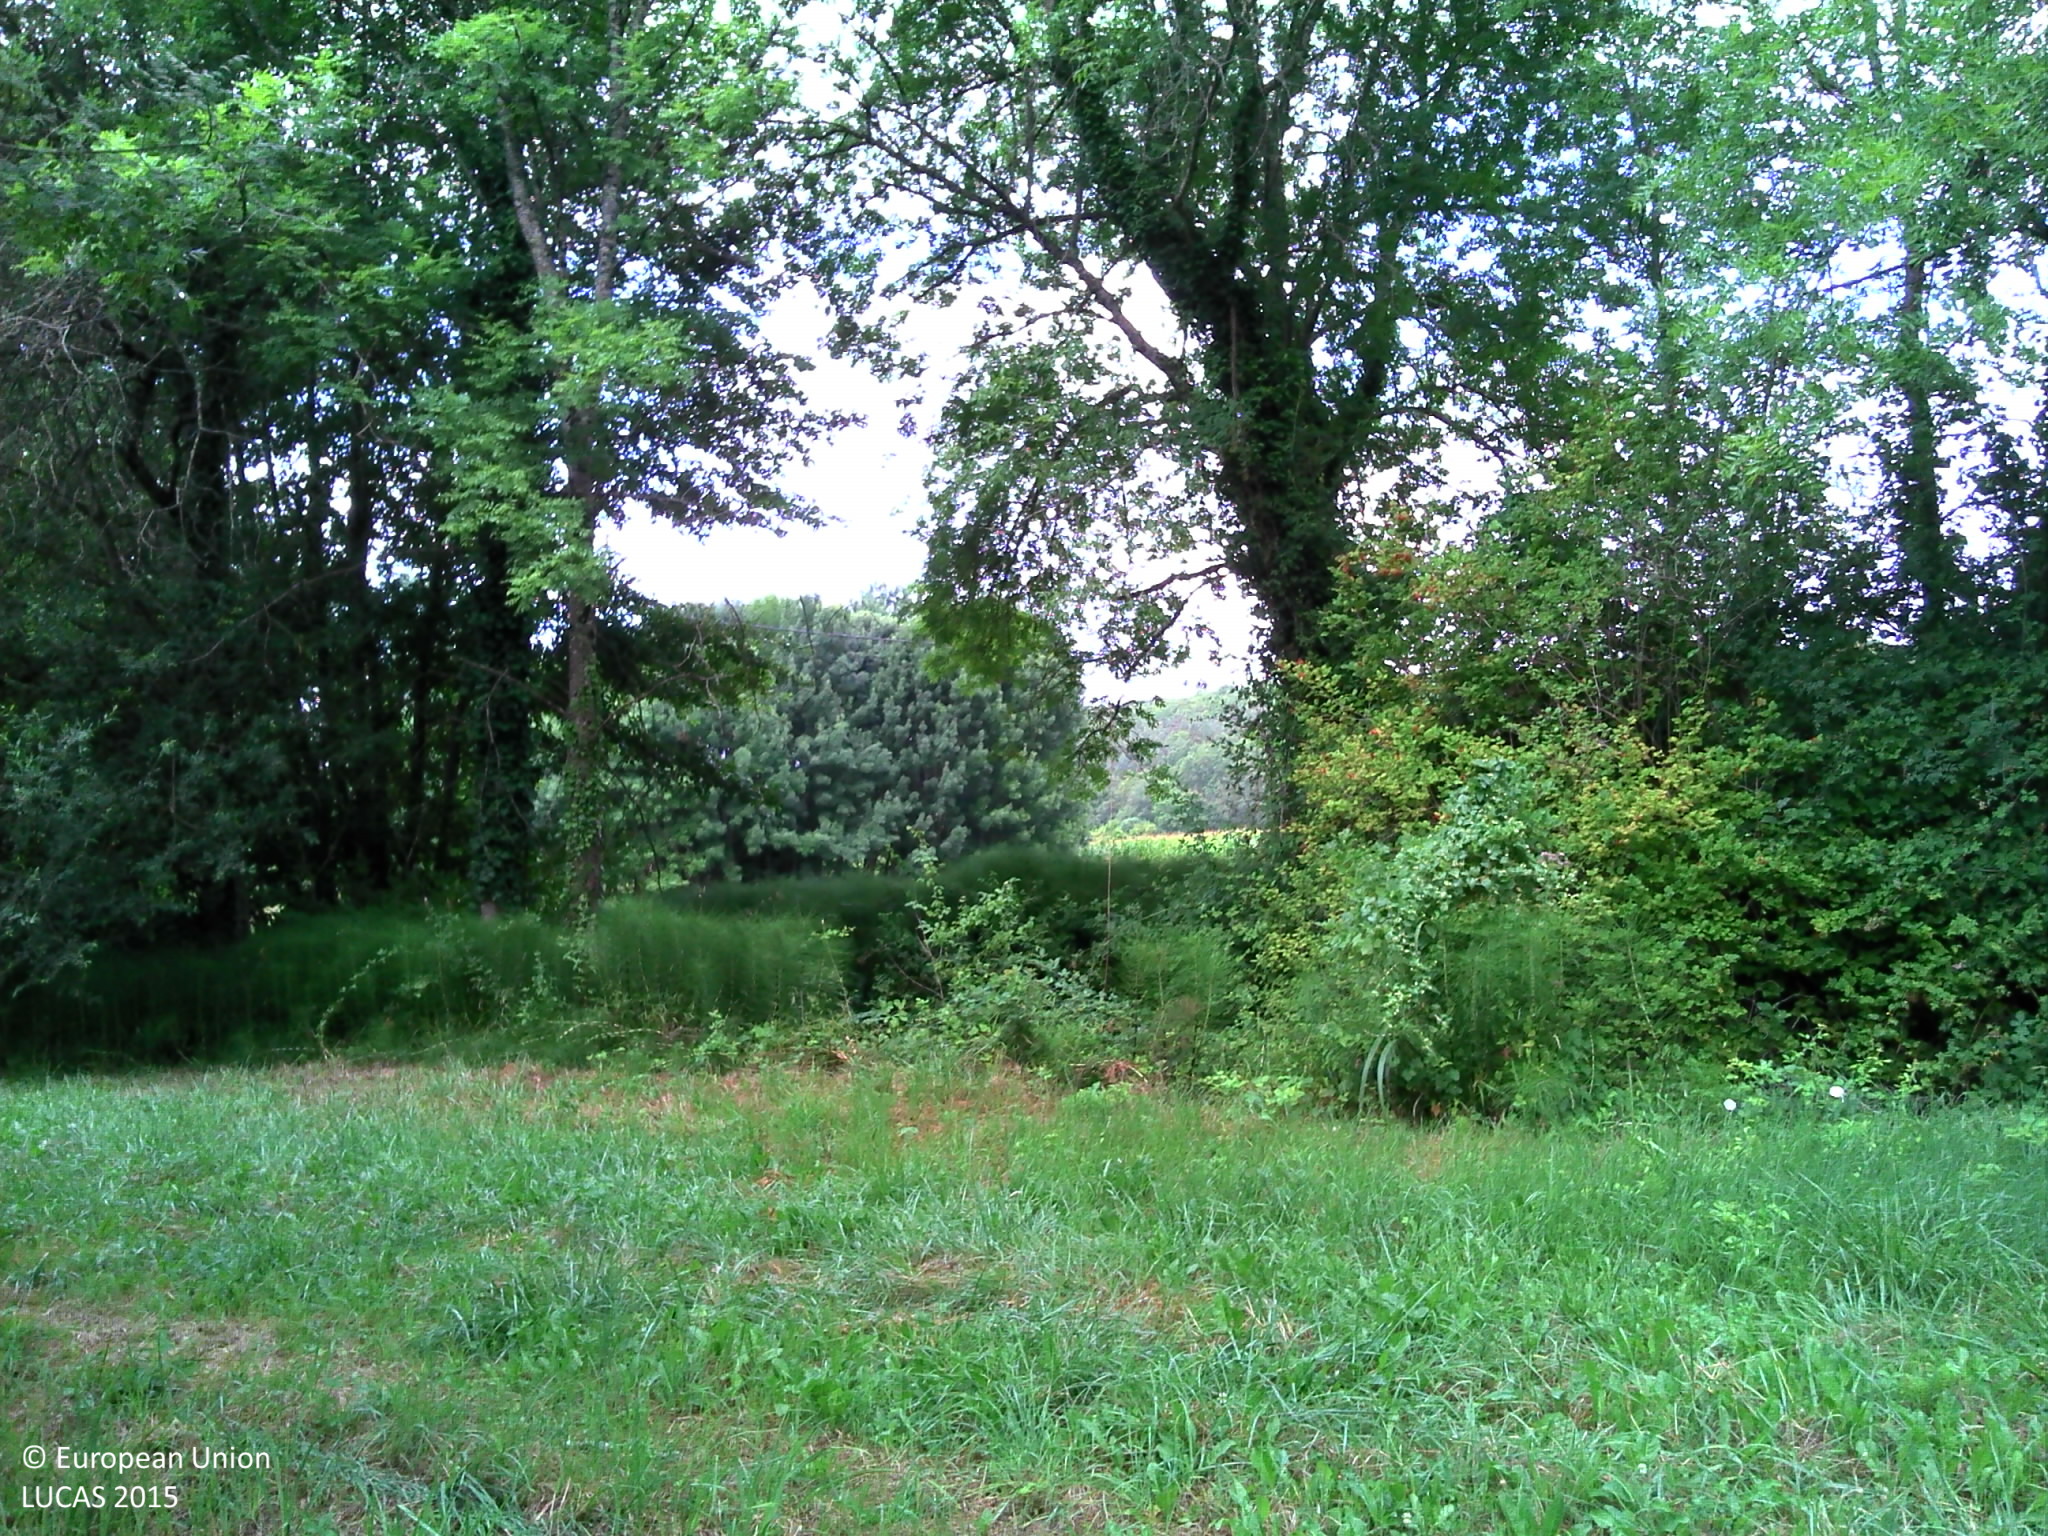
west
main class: Grassland
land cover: Spontaneously vegetated surfaces
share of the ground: > 75 %
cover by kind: herbaceous plants 95 %, shrubs 5 %
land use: Semi-natural and natural areas not in use
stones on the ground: < 10 %
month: July
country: FR
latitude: 44.9369
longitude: 0.7793
